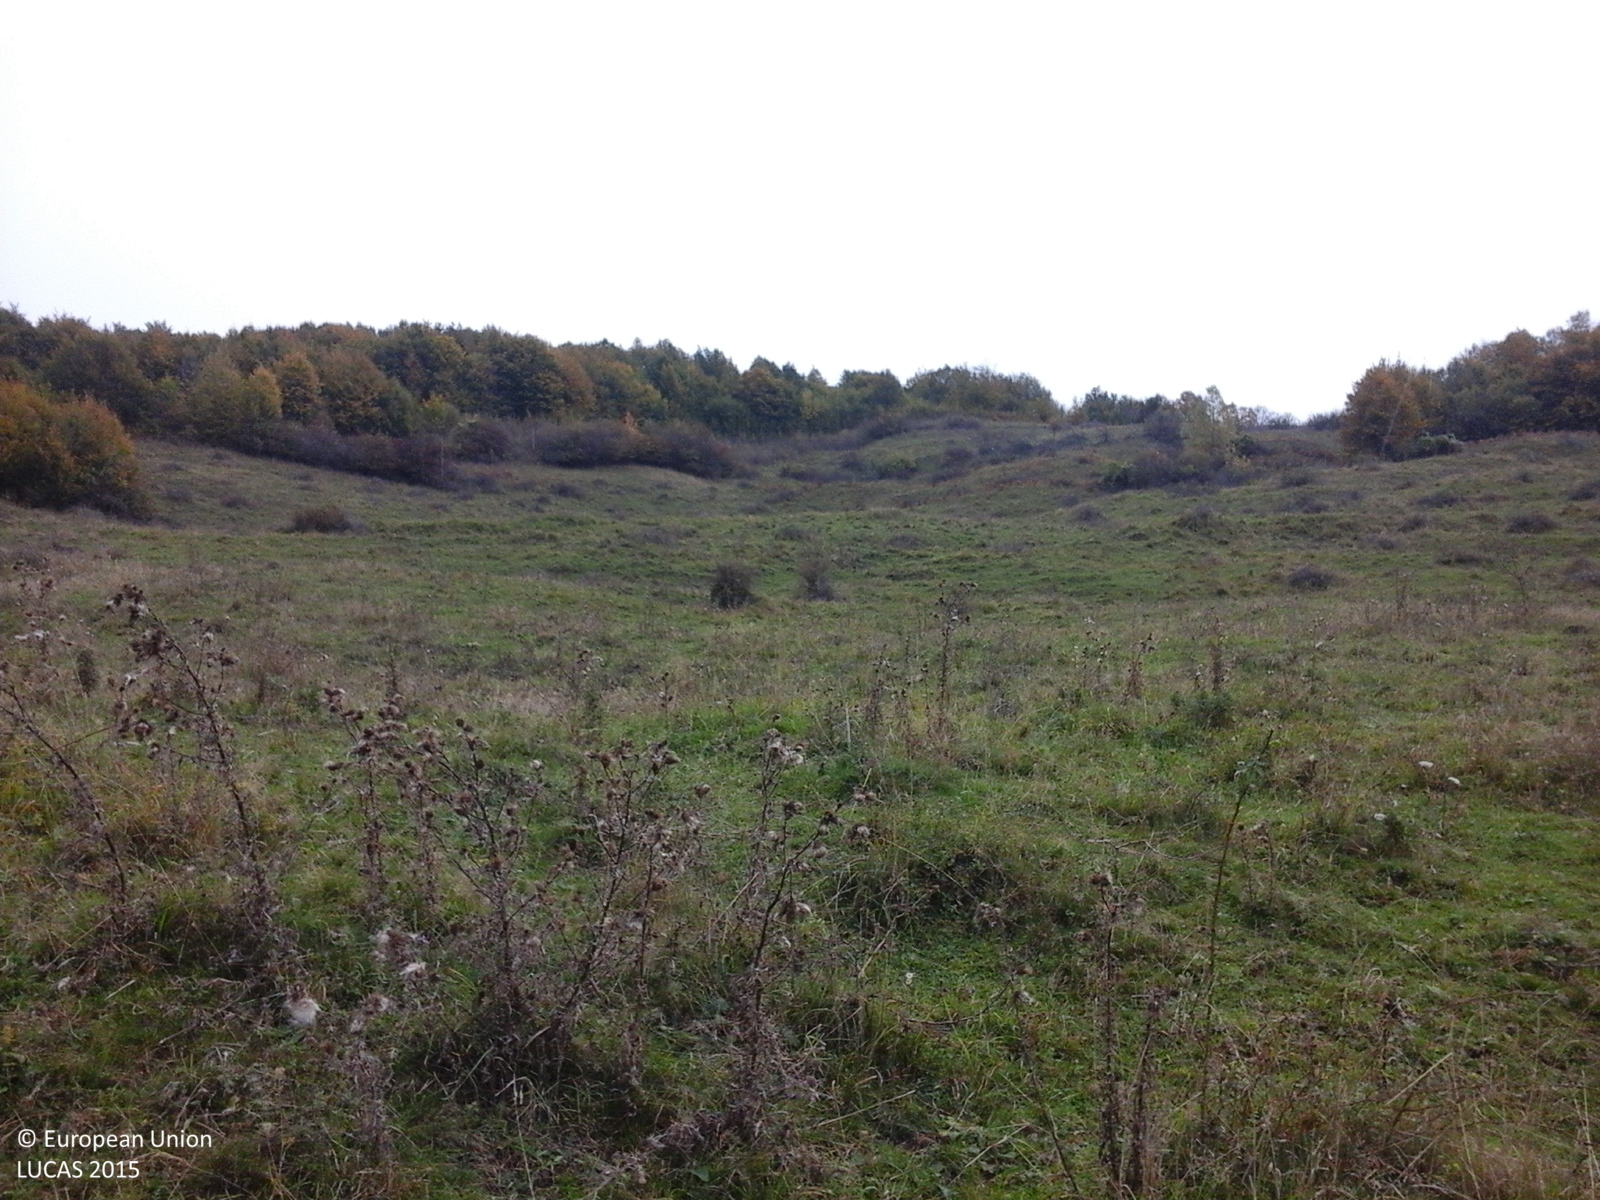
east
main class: Grassland
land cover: Grassland without tree/shrub cover
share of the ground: > 75 %
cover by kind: herbaceous plants 100 %
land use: Agriculture (excluding fallow land and kitchen gardens)
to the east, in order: Grassland without tree/shrub cover; Grassland with sparse tree/shrub cover; Broadleaved woodland
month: October
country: RO
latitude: 46.6157
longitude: 24.9172
